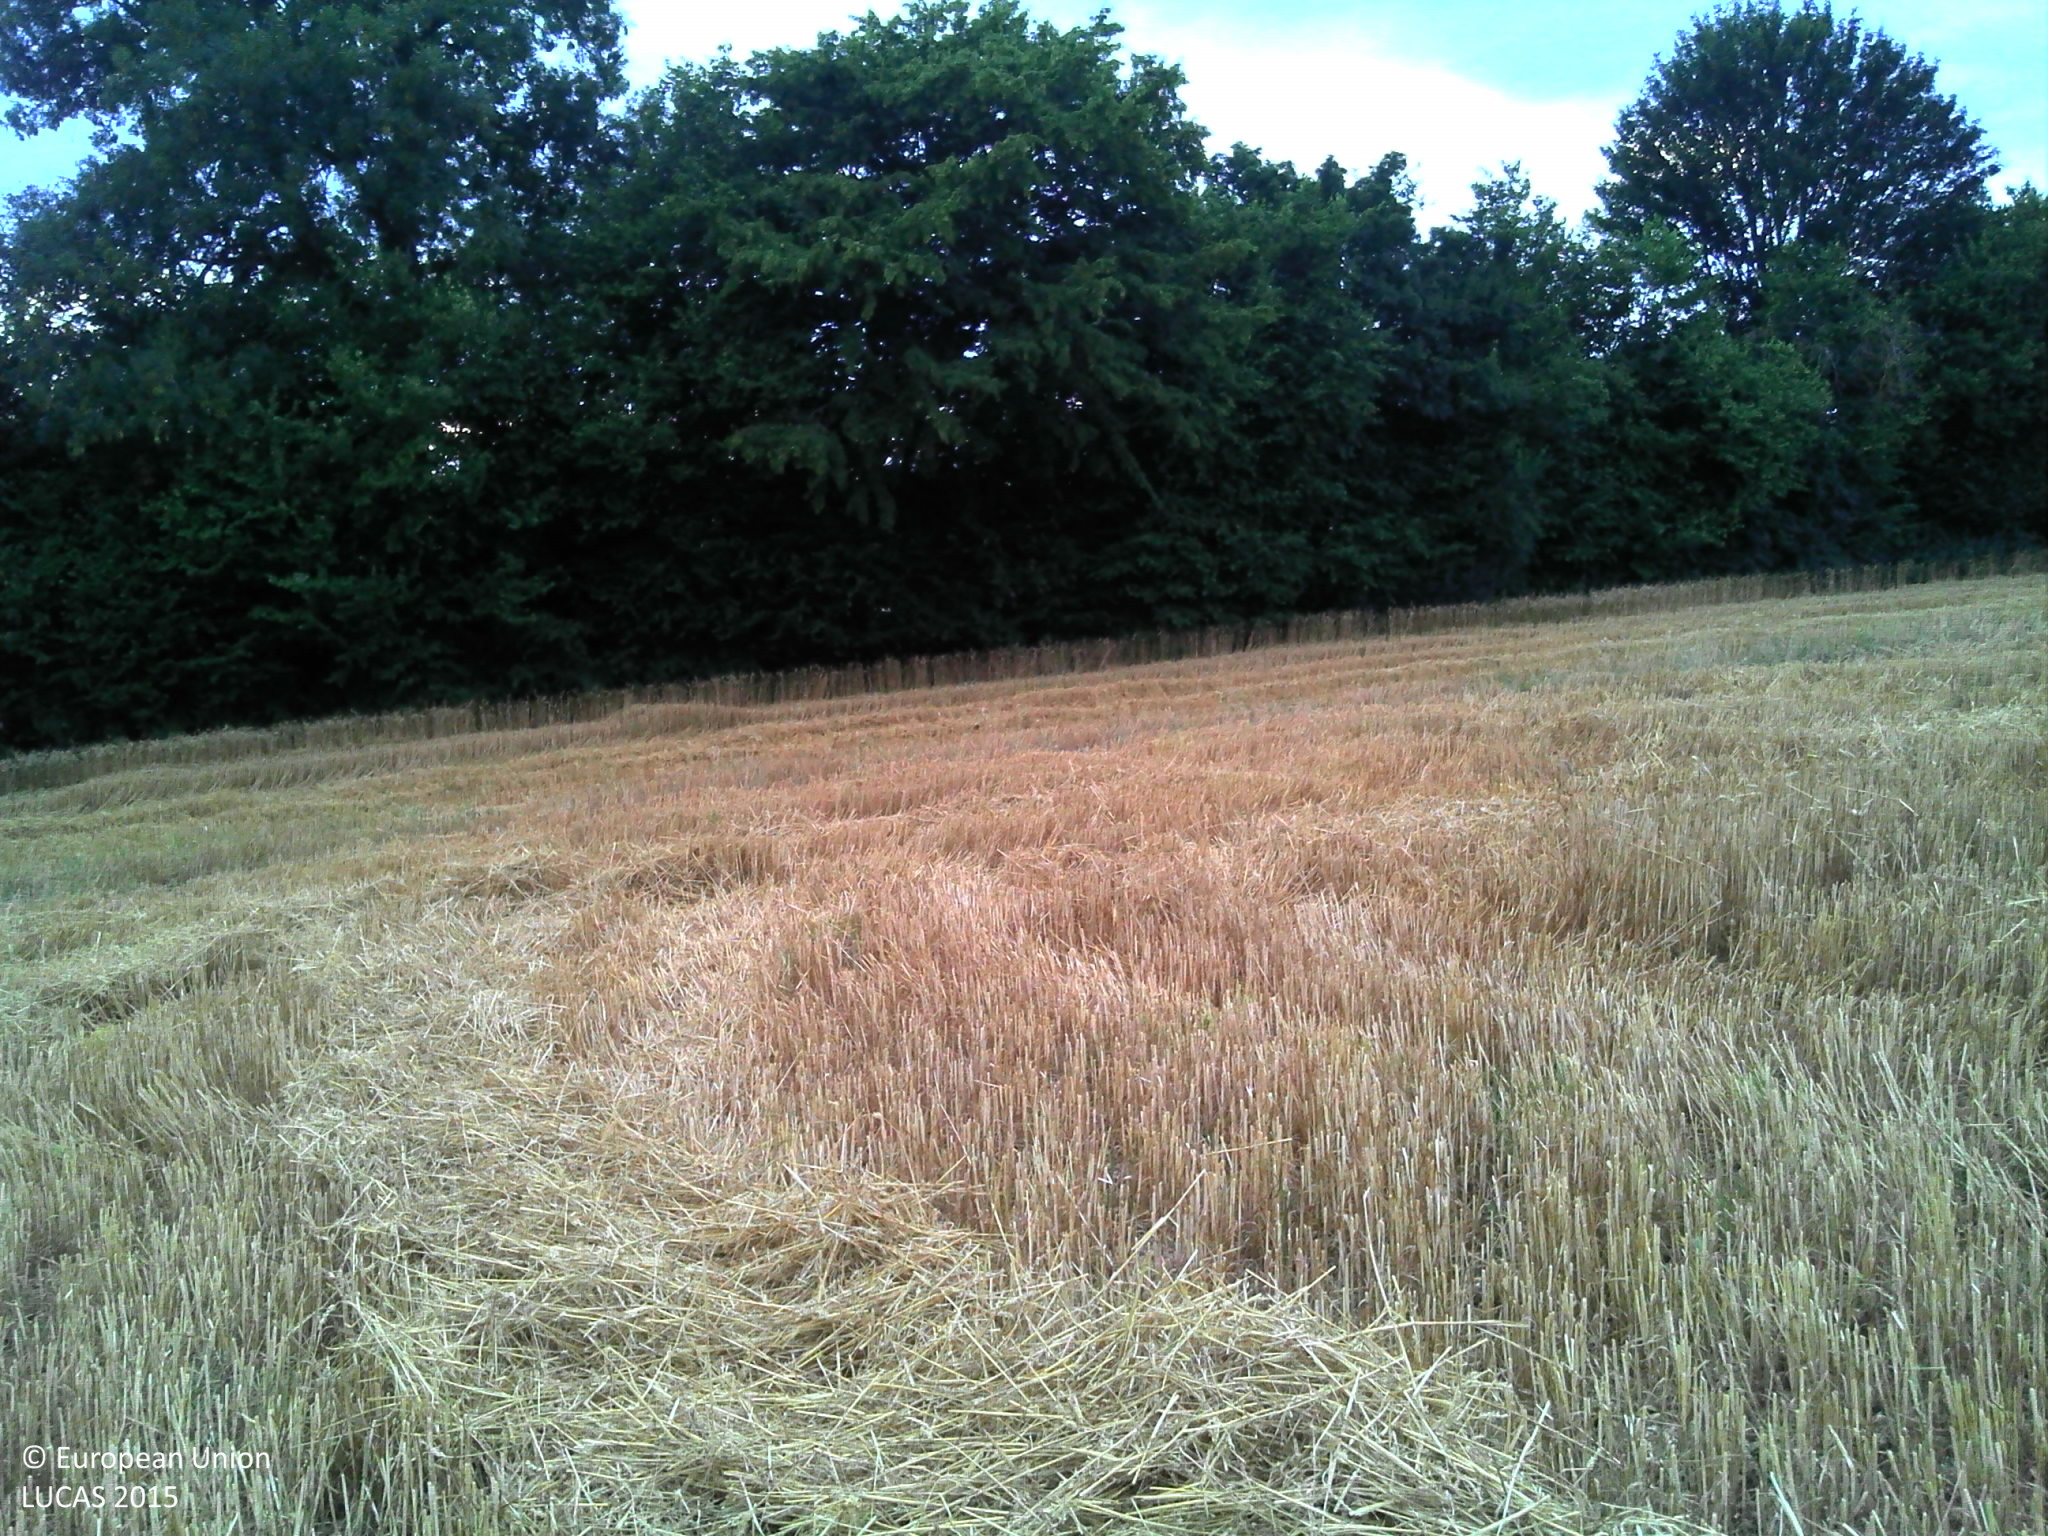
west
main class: Cropland
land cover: Common wheat
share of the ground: > 75 %
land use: Agriculture (excluding fallow land and kitchen gardens)
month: July
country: FR
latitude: 48.6470
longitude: 0.5145
